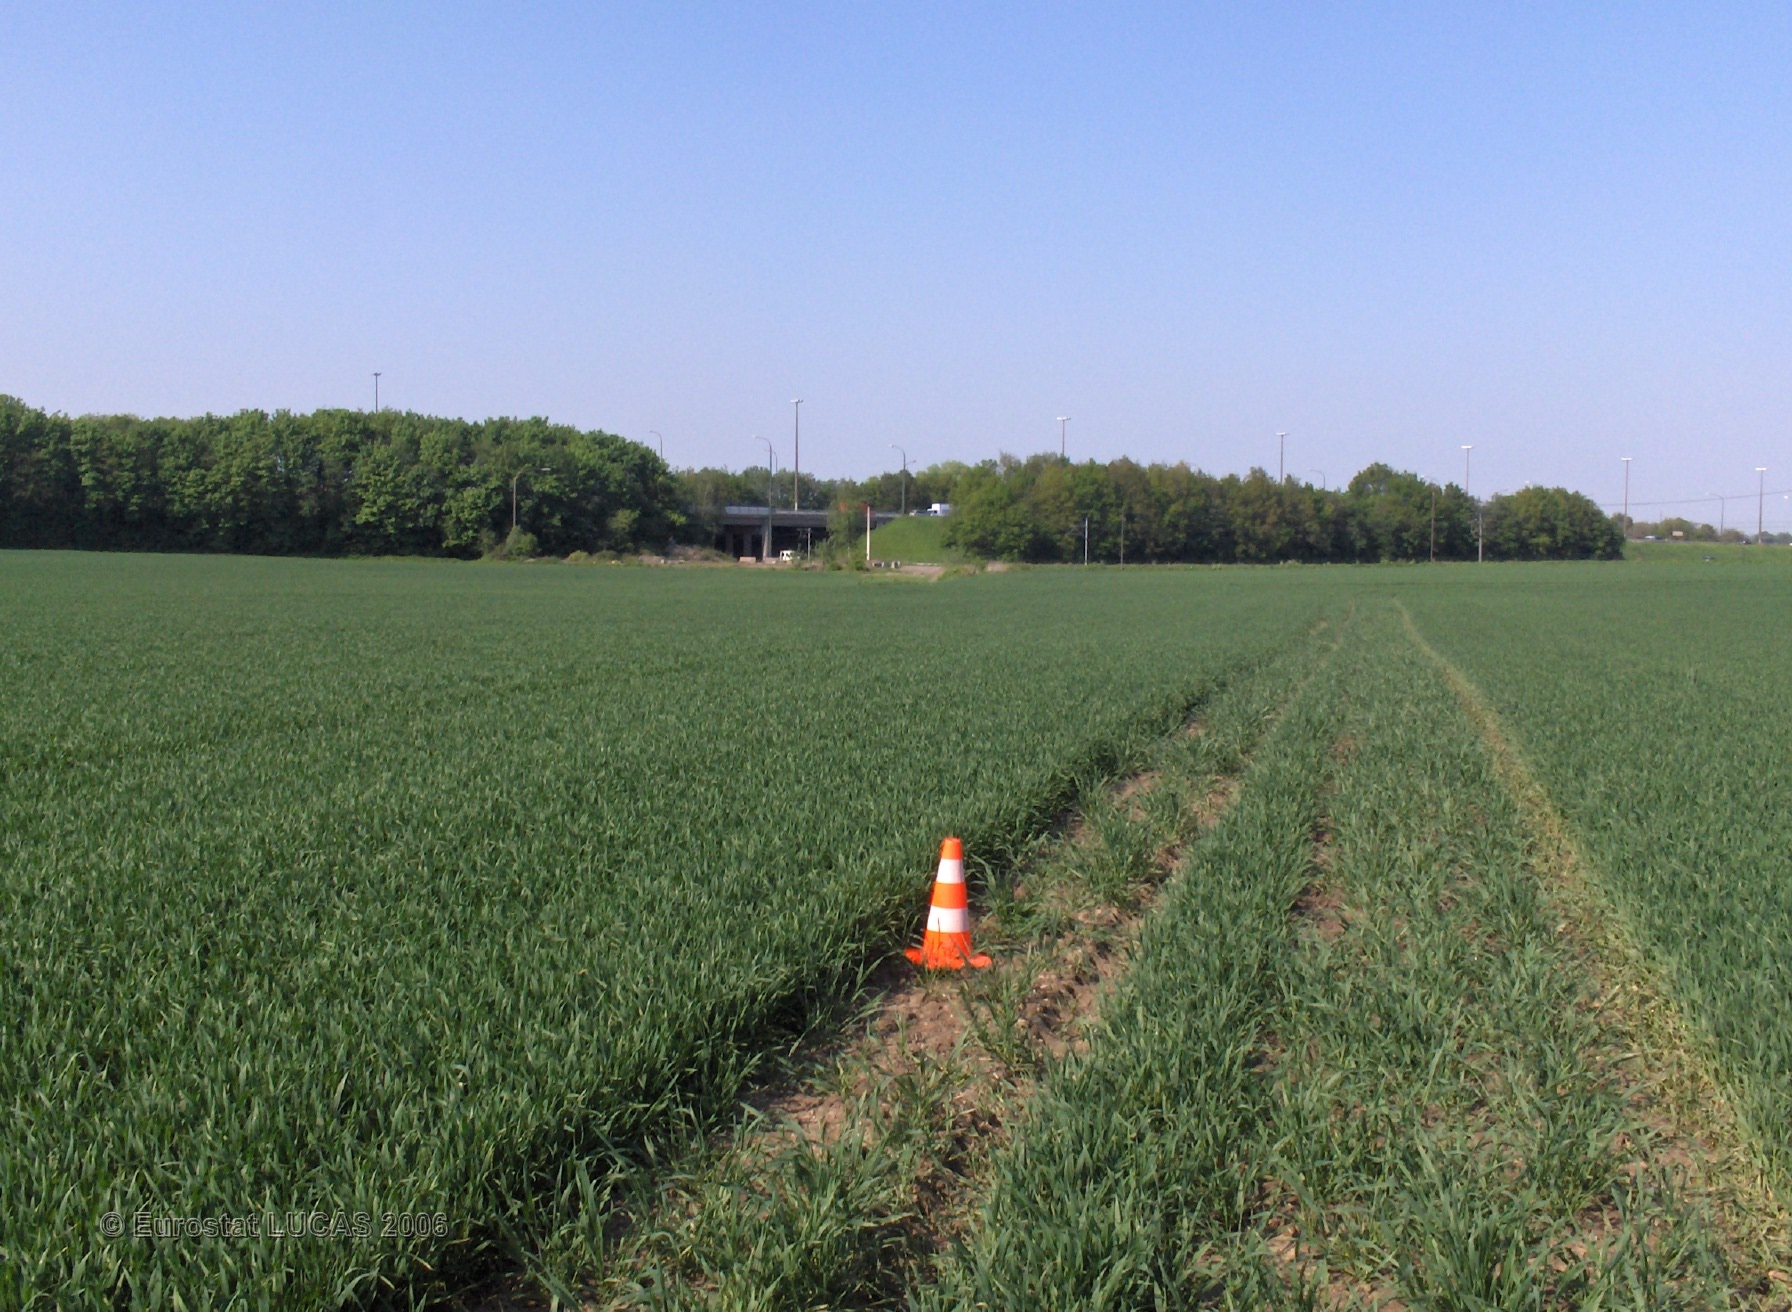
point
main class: Cropland
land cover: Common wheat
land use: Agriculture (excluding fallow land and kitchen gardens)
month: May
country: BE
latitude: 50.4682
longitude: 4.5436
